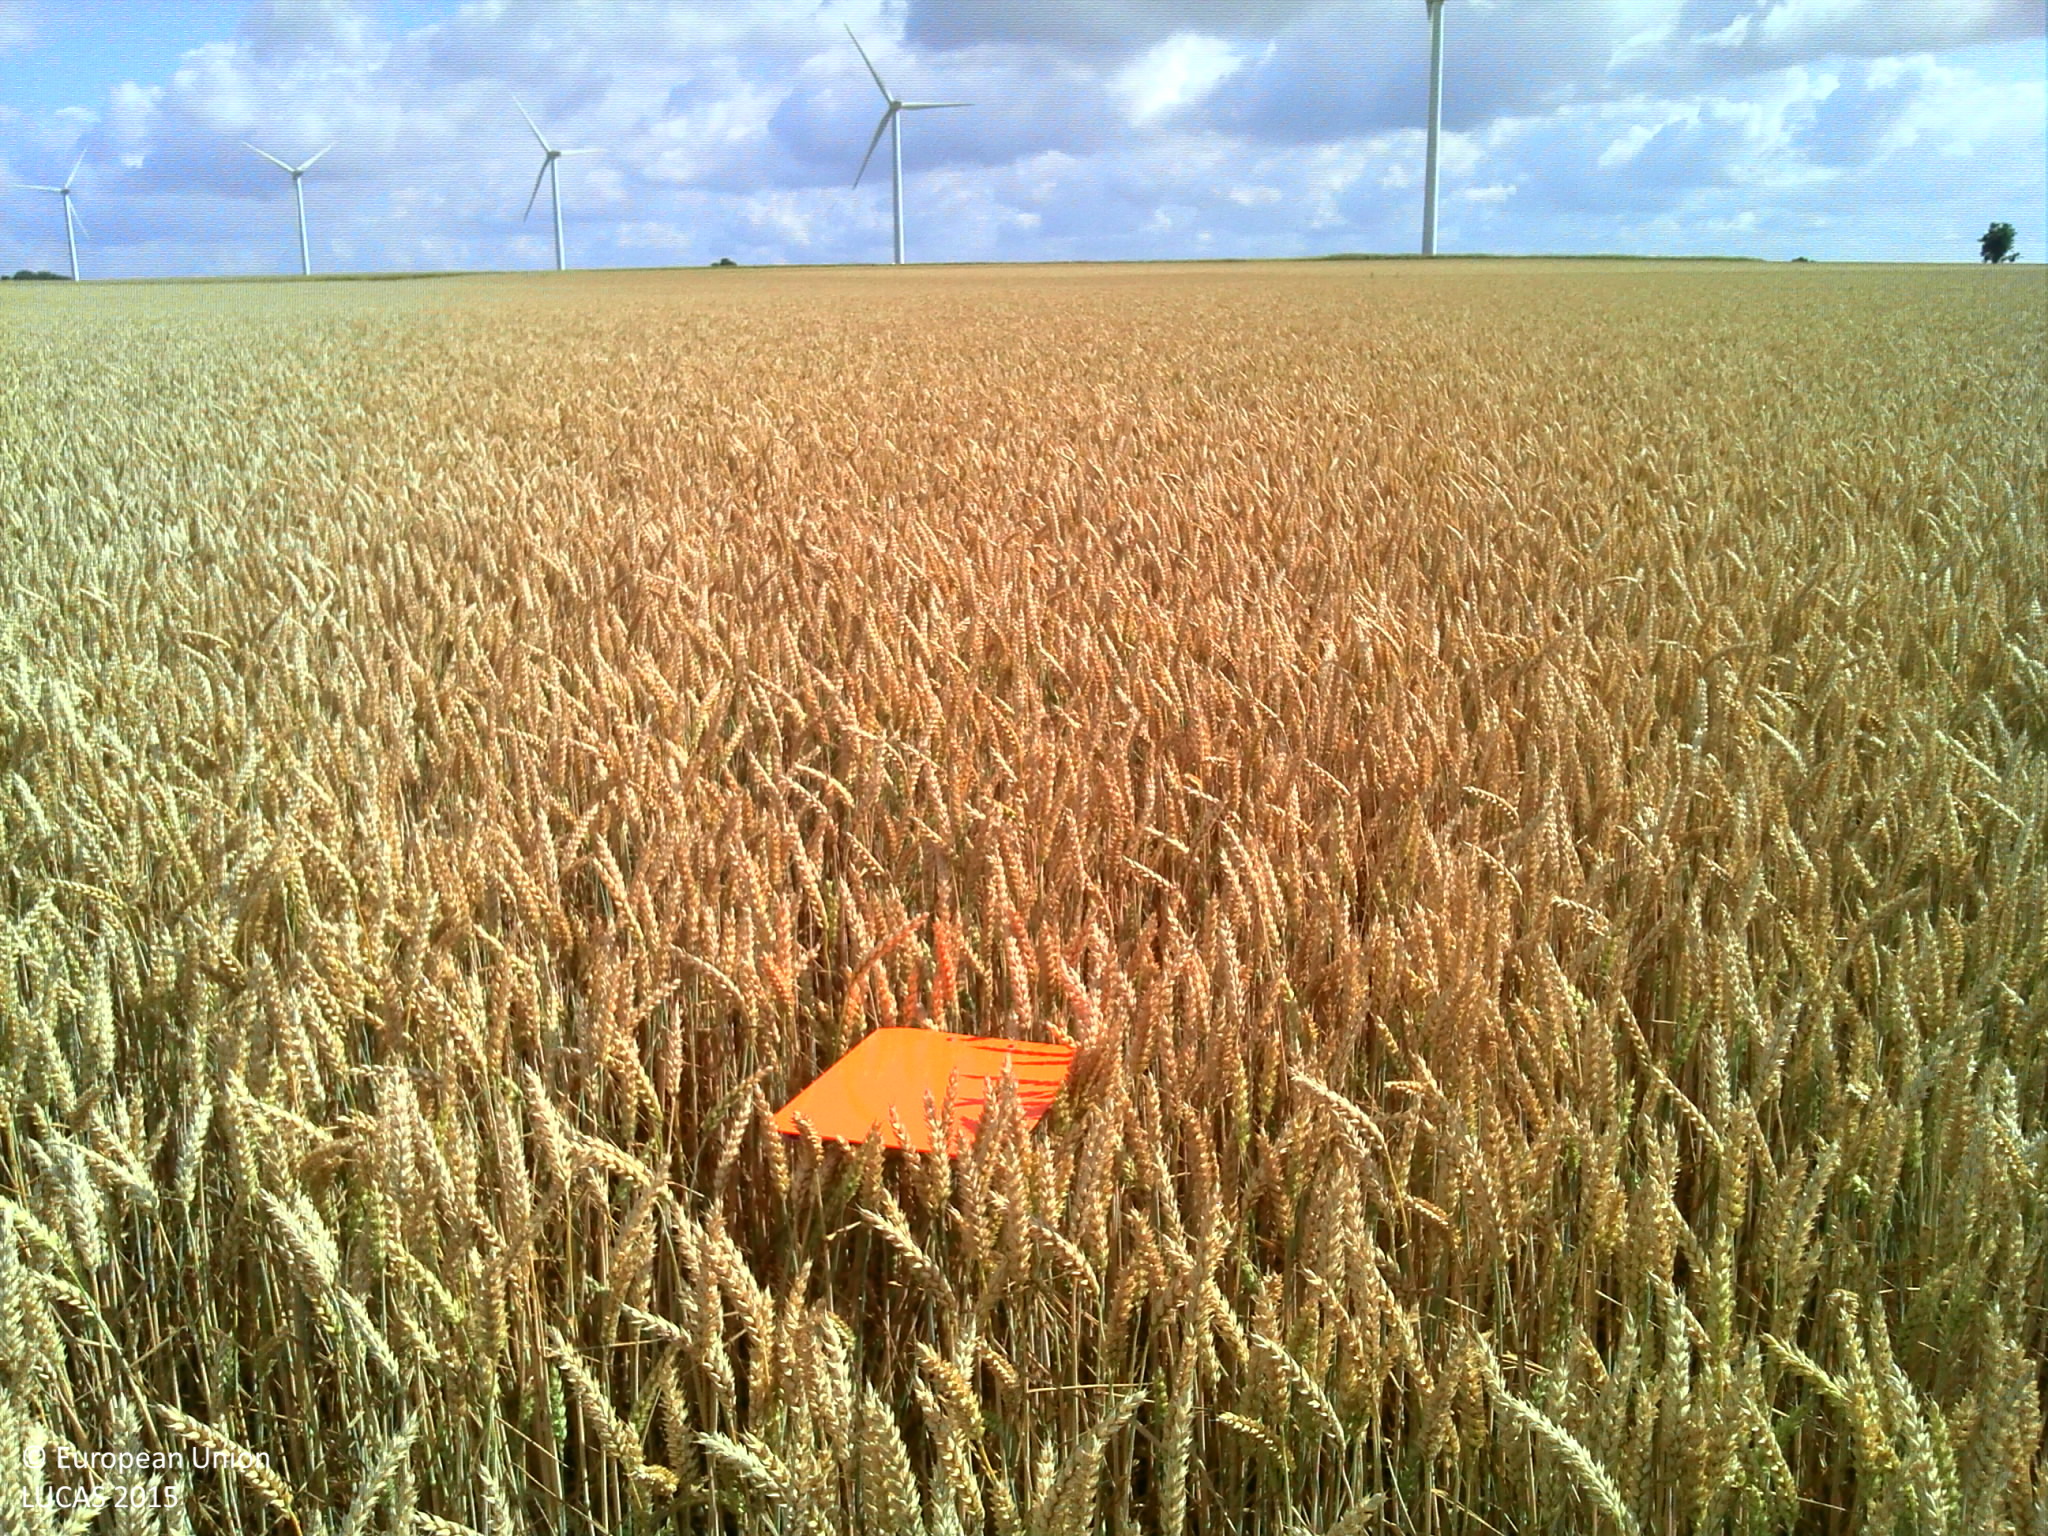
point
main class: Cropland
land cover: Common wheat
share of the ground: > 75 %
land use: Agriculture (excluding fallow land and kitchen gardens)
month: July
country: FR
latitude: 48.9278
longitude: -0.2012
